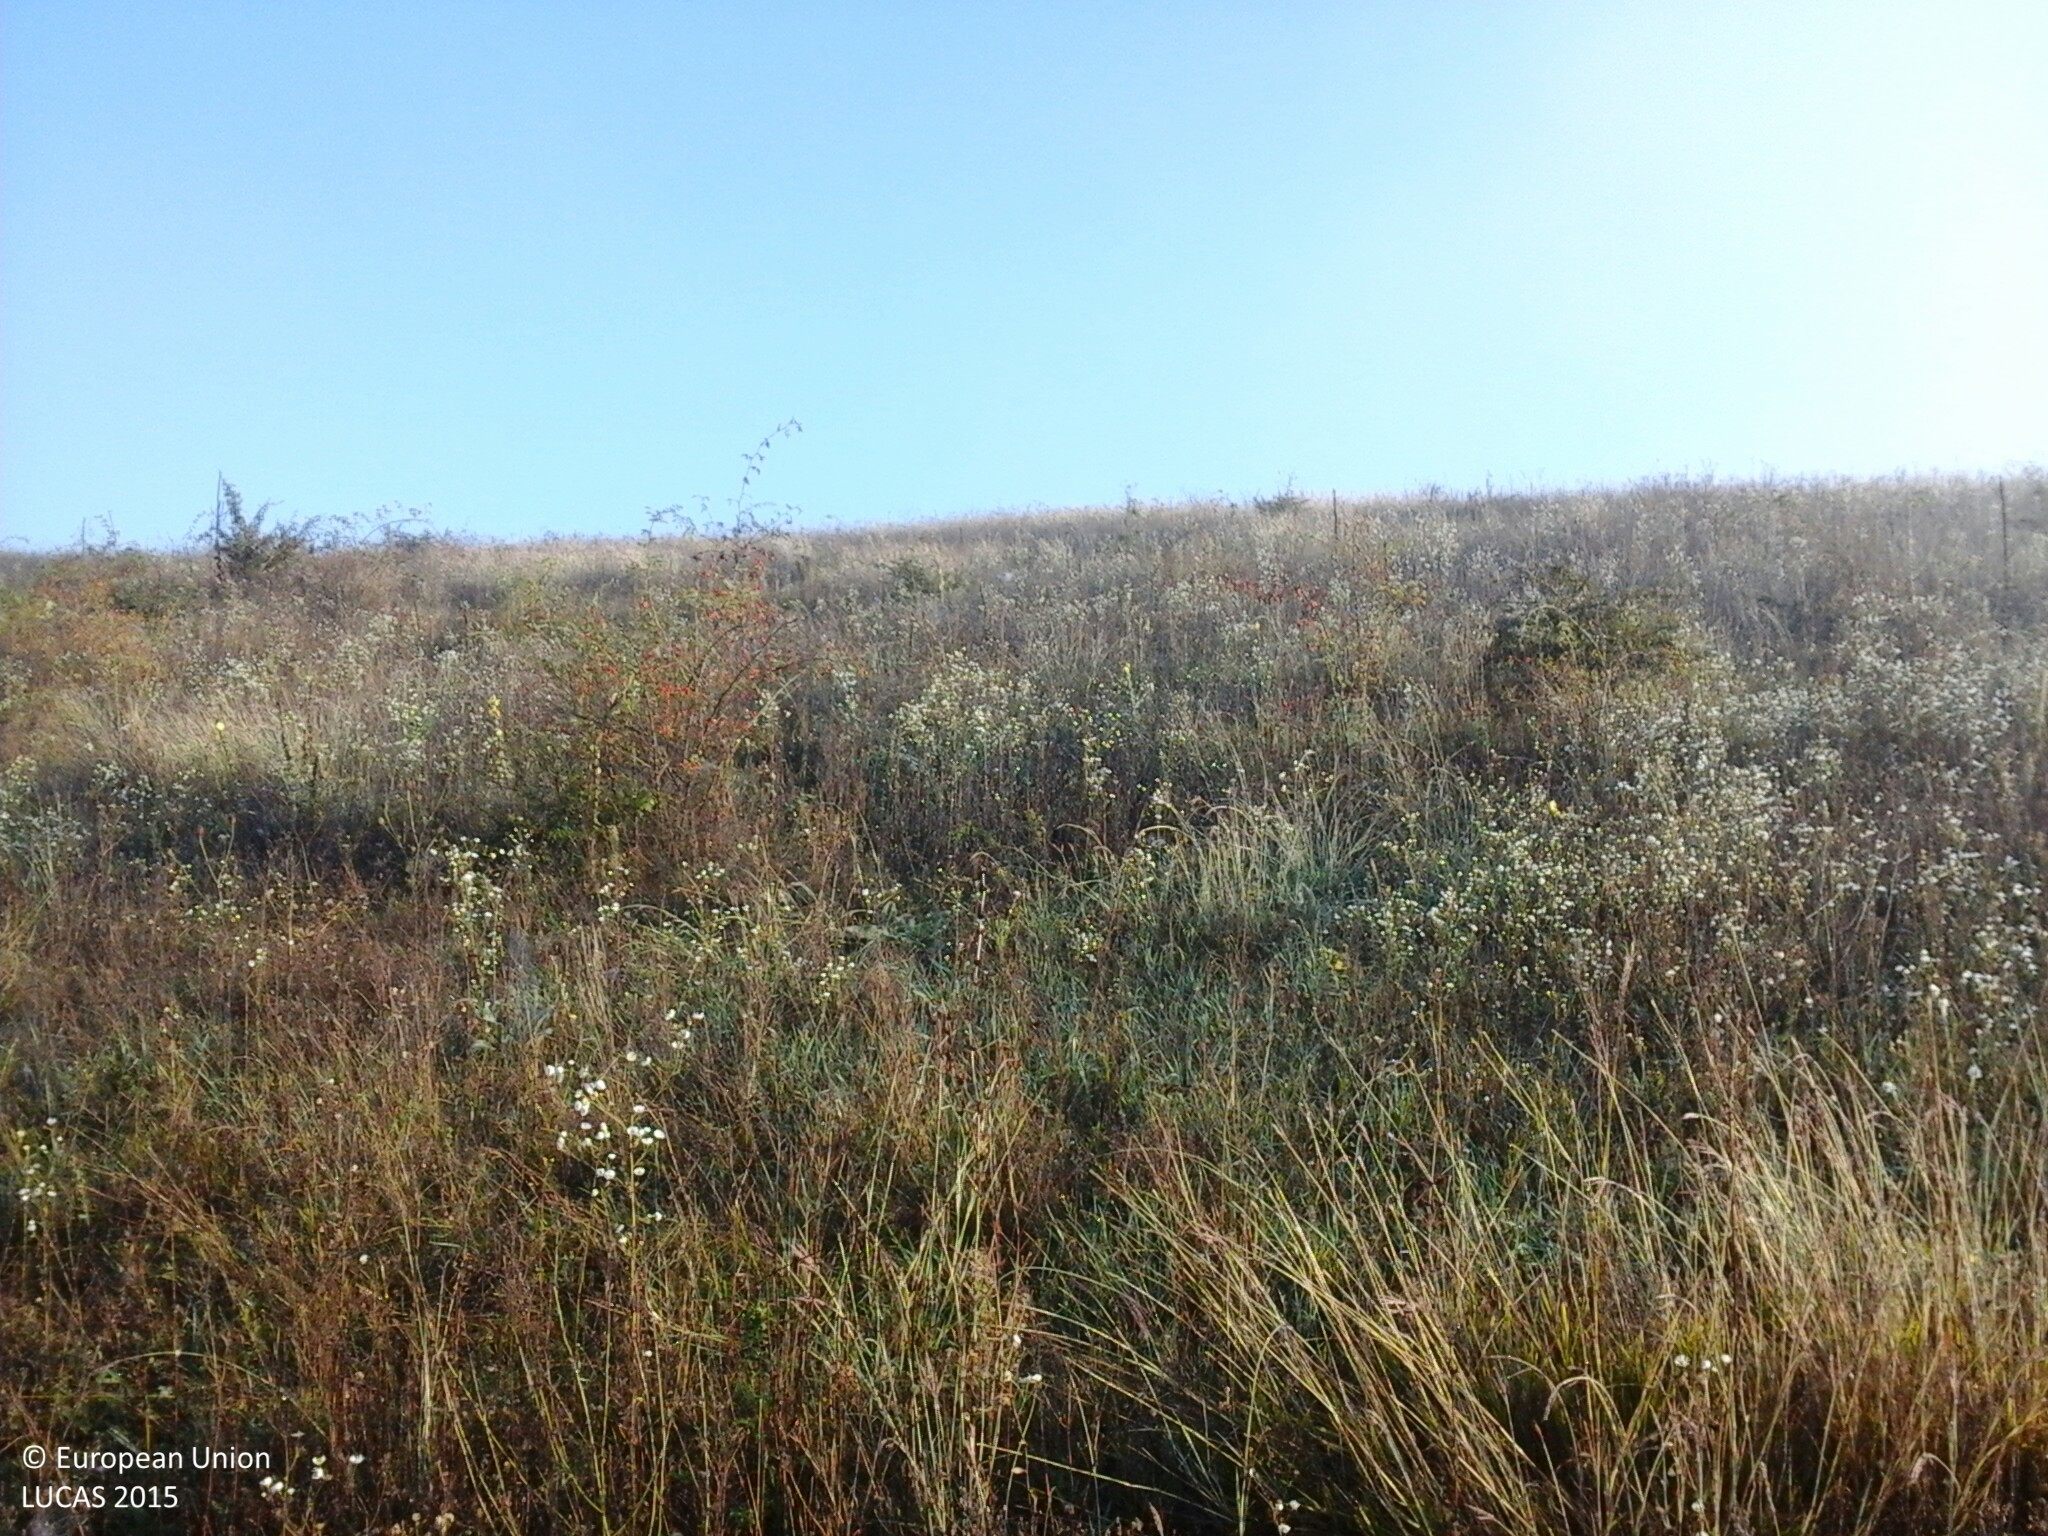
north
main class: Grassland
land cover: Spontaneously vegetated surfaces
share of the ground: > 75 %
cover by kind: herbaceous plants 100 %
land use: Semi-natural and natural areas not in use
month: September
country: HU
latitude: 48.1649
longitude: 20.0186
